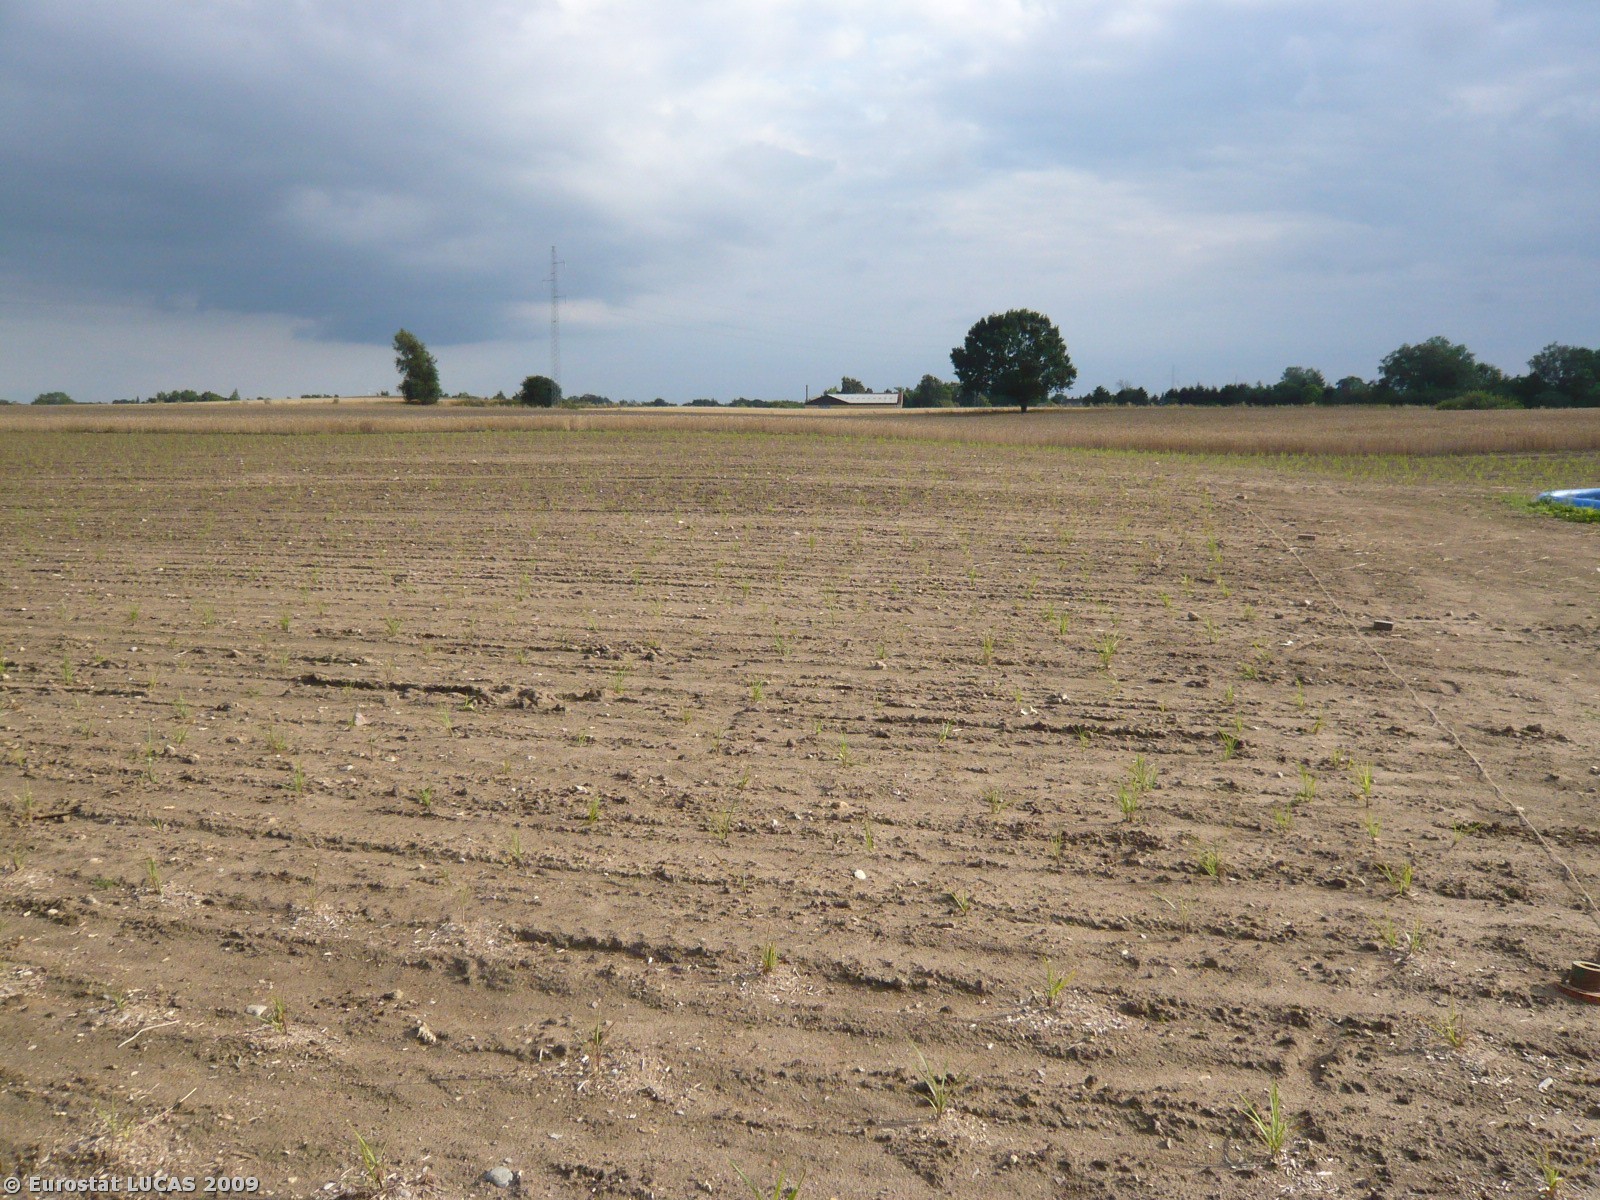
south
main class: Cropland
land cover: Barley
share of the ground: < 10 %
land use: Agriculture (excluding fallow land and kitchen gardens)
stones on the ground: 10 - 25 %
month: May
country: DK
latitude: 55.2974
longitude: 11.5580
